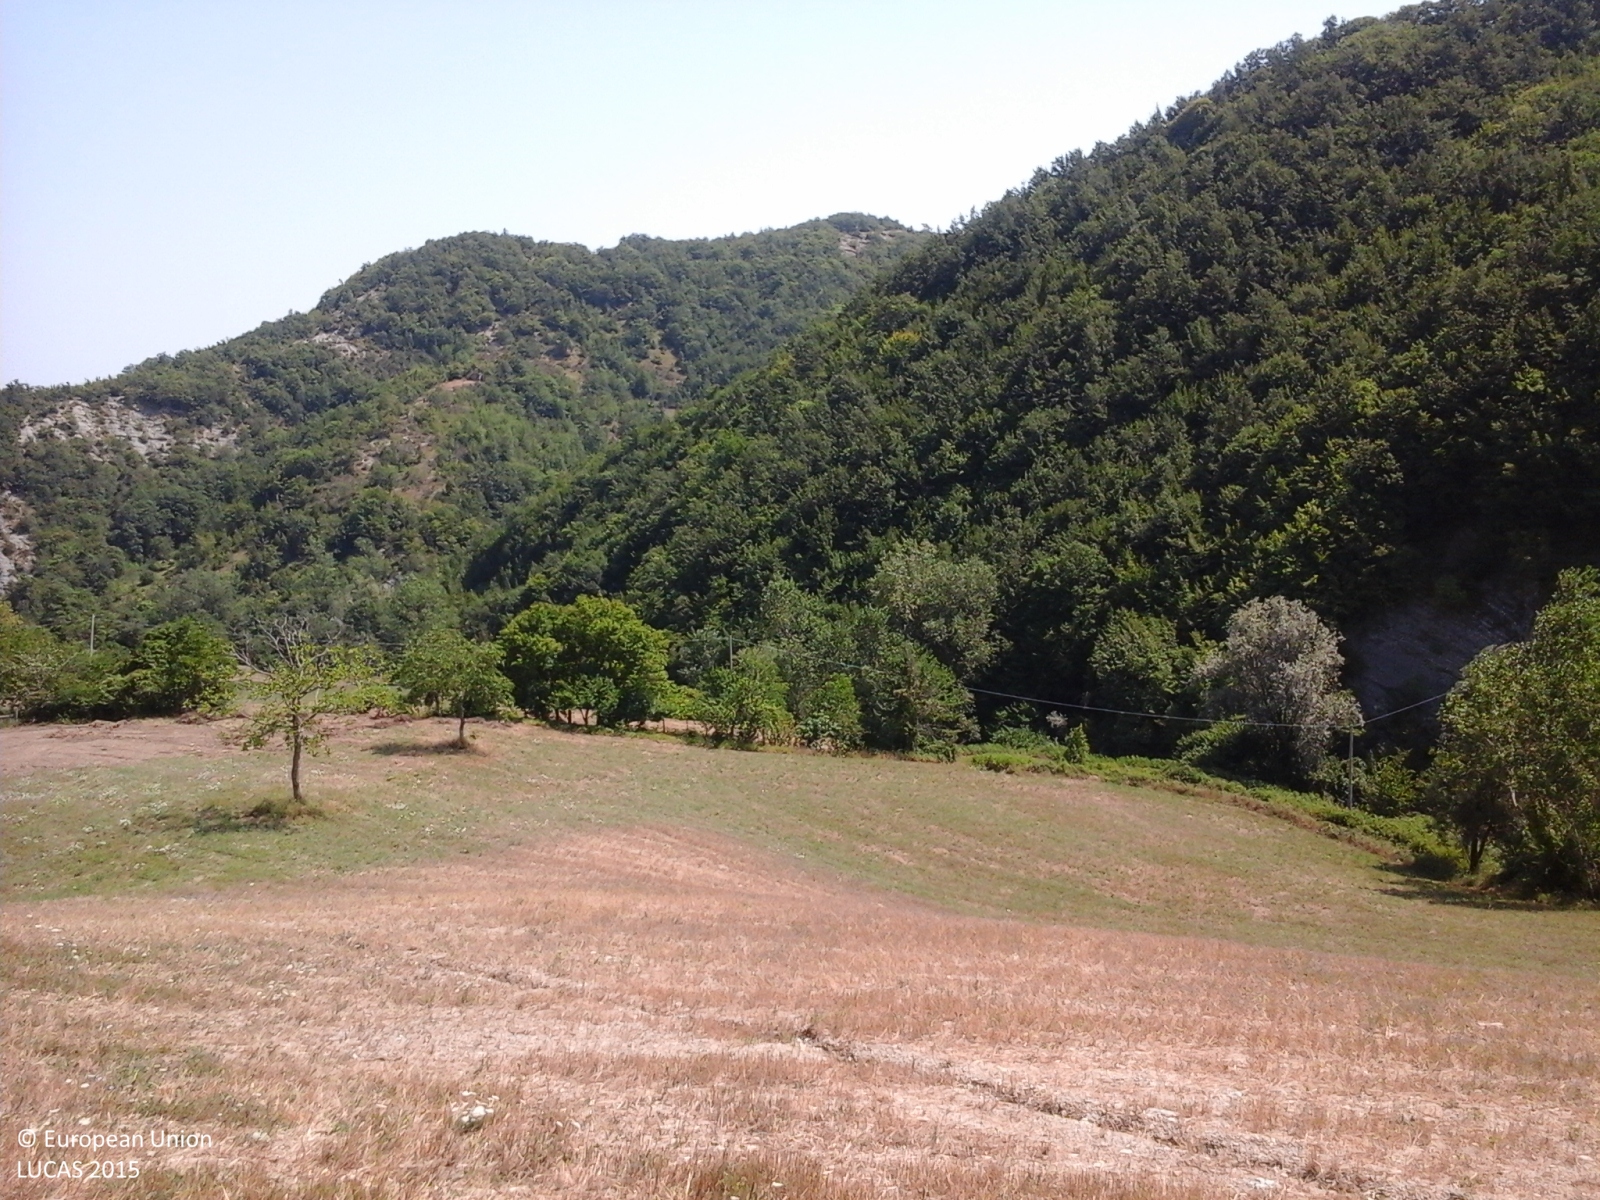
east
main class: Woodland
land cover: Broadleaved woodland
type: thermophilous deciduous forest
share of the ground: > 75 %
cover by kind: broadleaved forest trees 100 %
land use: Forestry
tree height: > 5 m
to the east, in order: Broadleaved woodland; Lucerne; Abandoned hedges; Tracks; Fences; Electric lines; Abandoned hedges; Lucerne; Broadleaved woodland
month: August
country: IT
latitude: 43.6942
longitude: 12.2648
